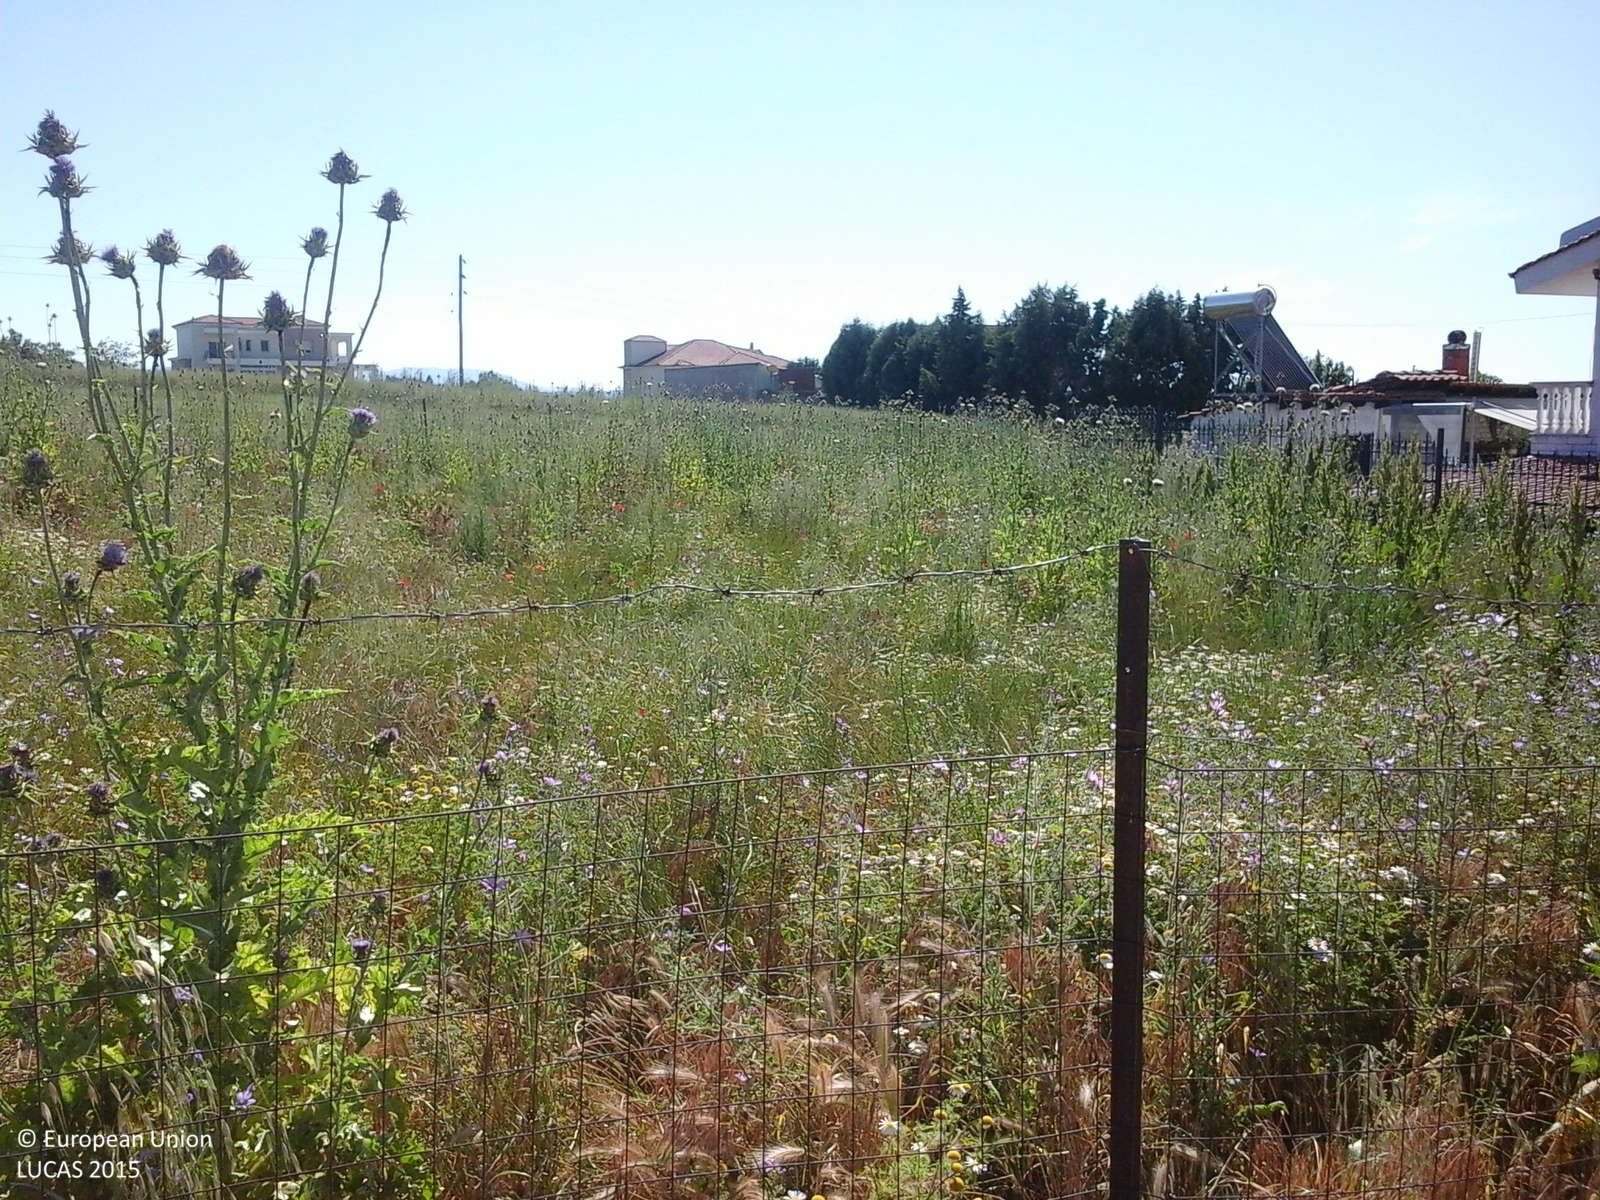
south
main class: Grassland
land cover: Spontaneously vegetated surfaces
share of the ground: > 75 %
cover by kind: herbaceous plants 10 %
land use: Fallow land
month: May
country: GR
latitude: 40.7758
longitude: 22.9593
